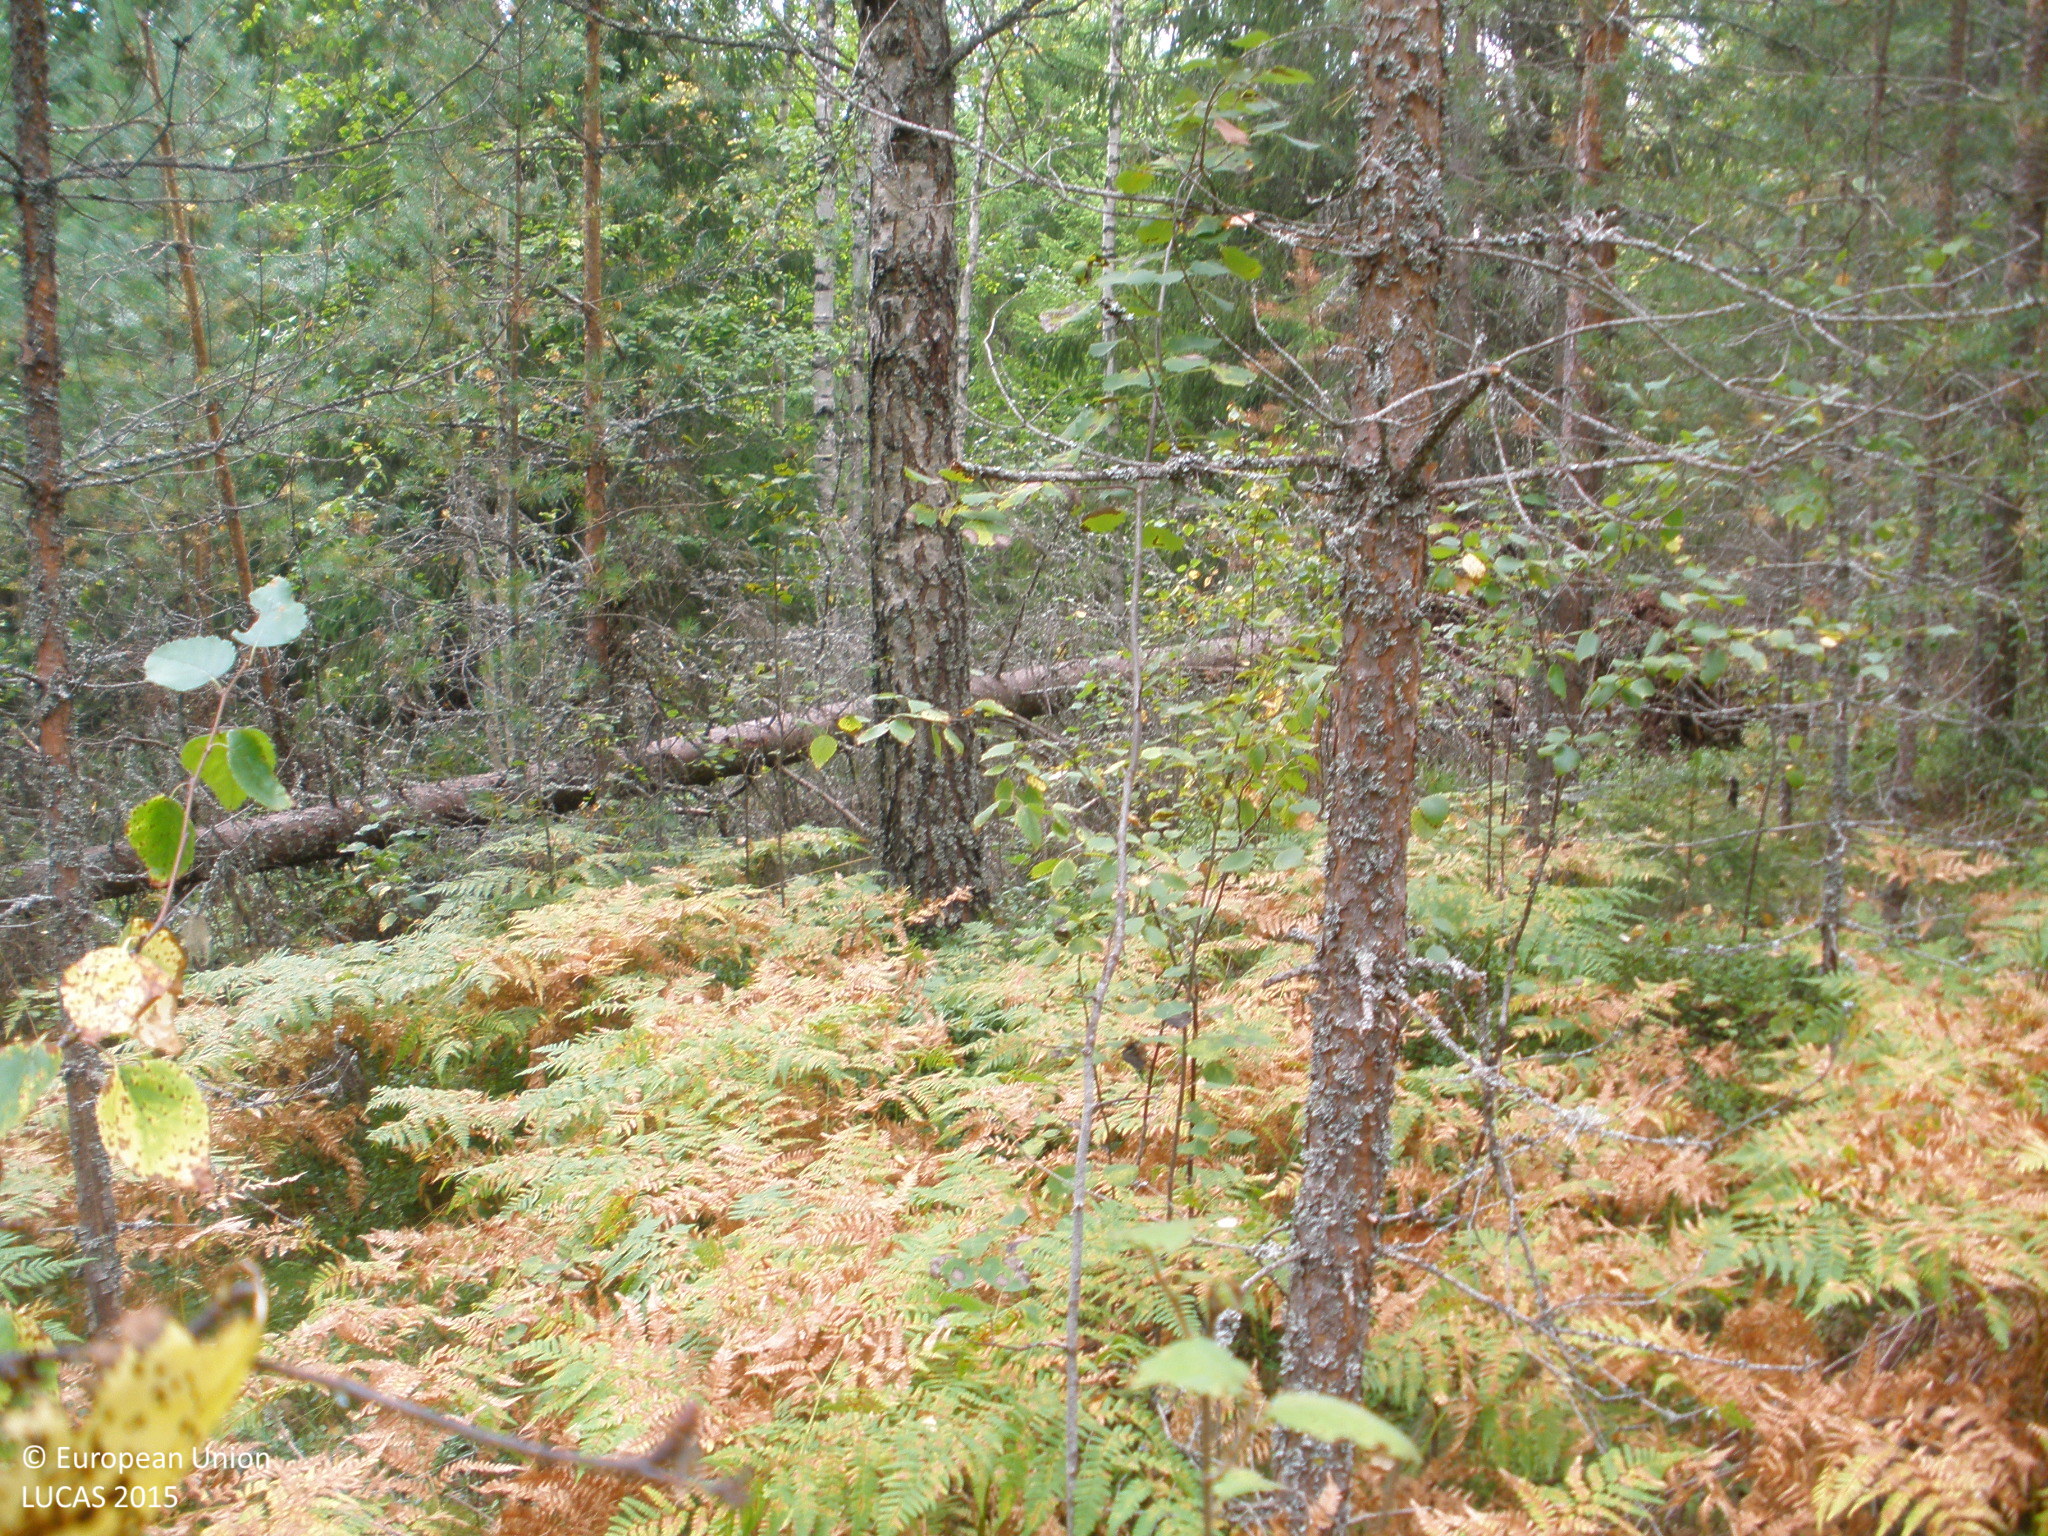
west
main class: Woodland
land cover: Pine dominated mixed woodland
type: boreal forest
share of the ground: > 75 %
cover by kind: coniferous forest trees 60 %, broadleaved forest trees 25 %, herbaceous plants 10 %, lichens and mosses 5 %
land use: Forestry
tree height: > 5 m
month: August
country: FI
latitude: 60.6033
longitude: 23.5471
